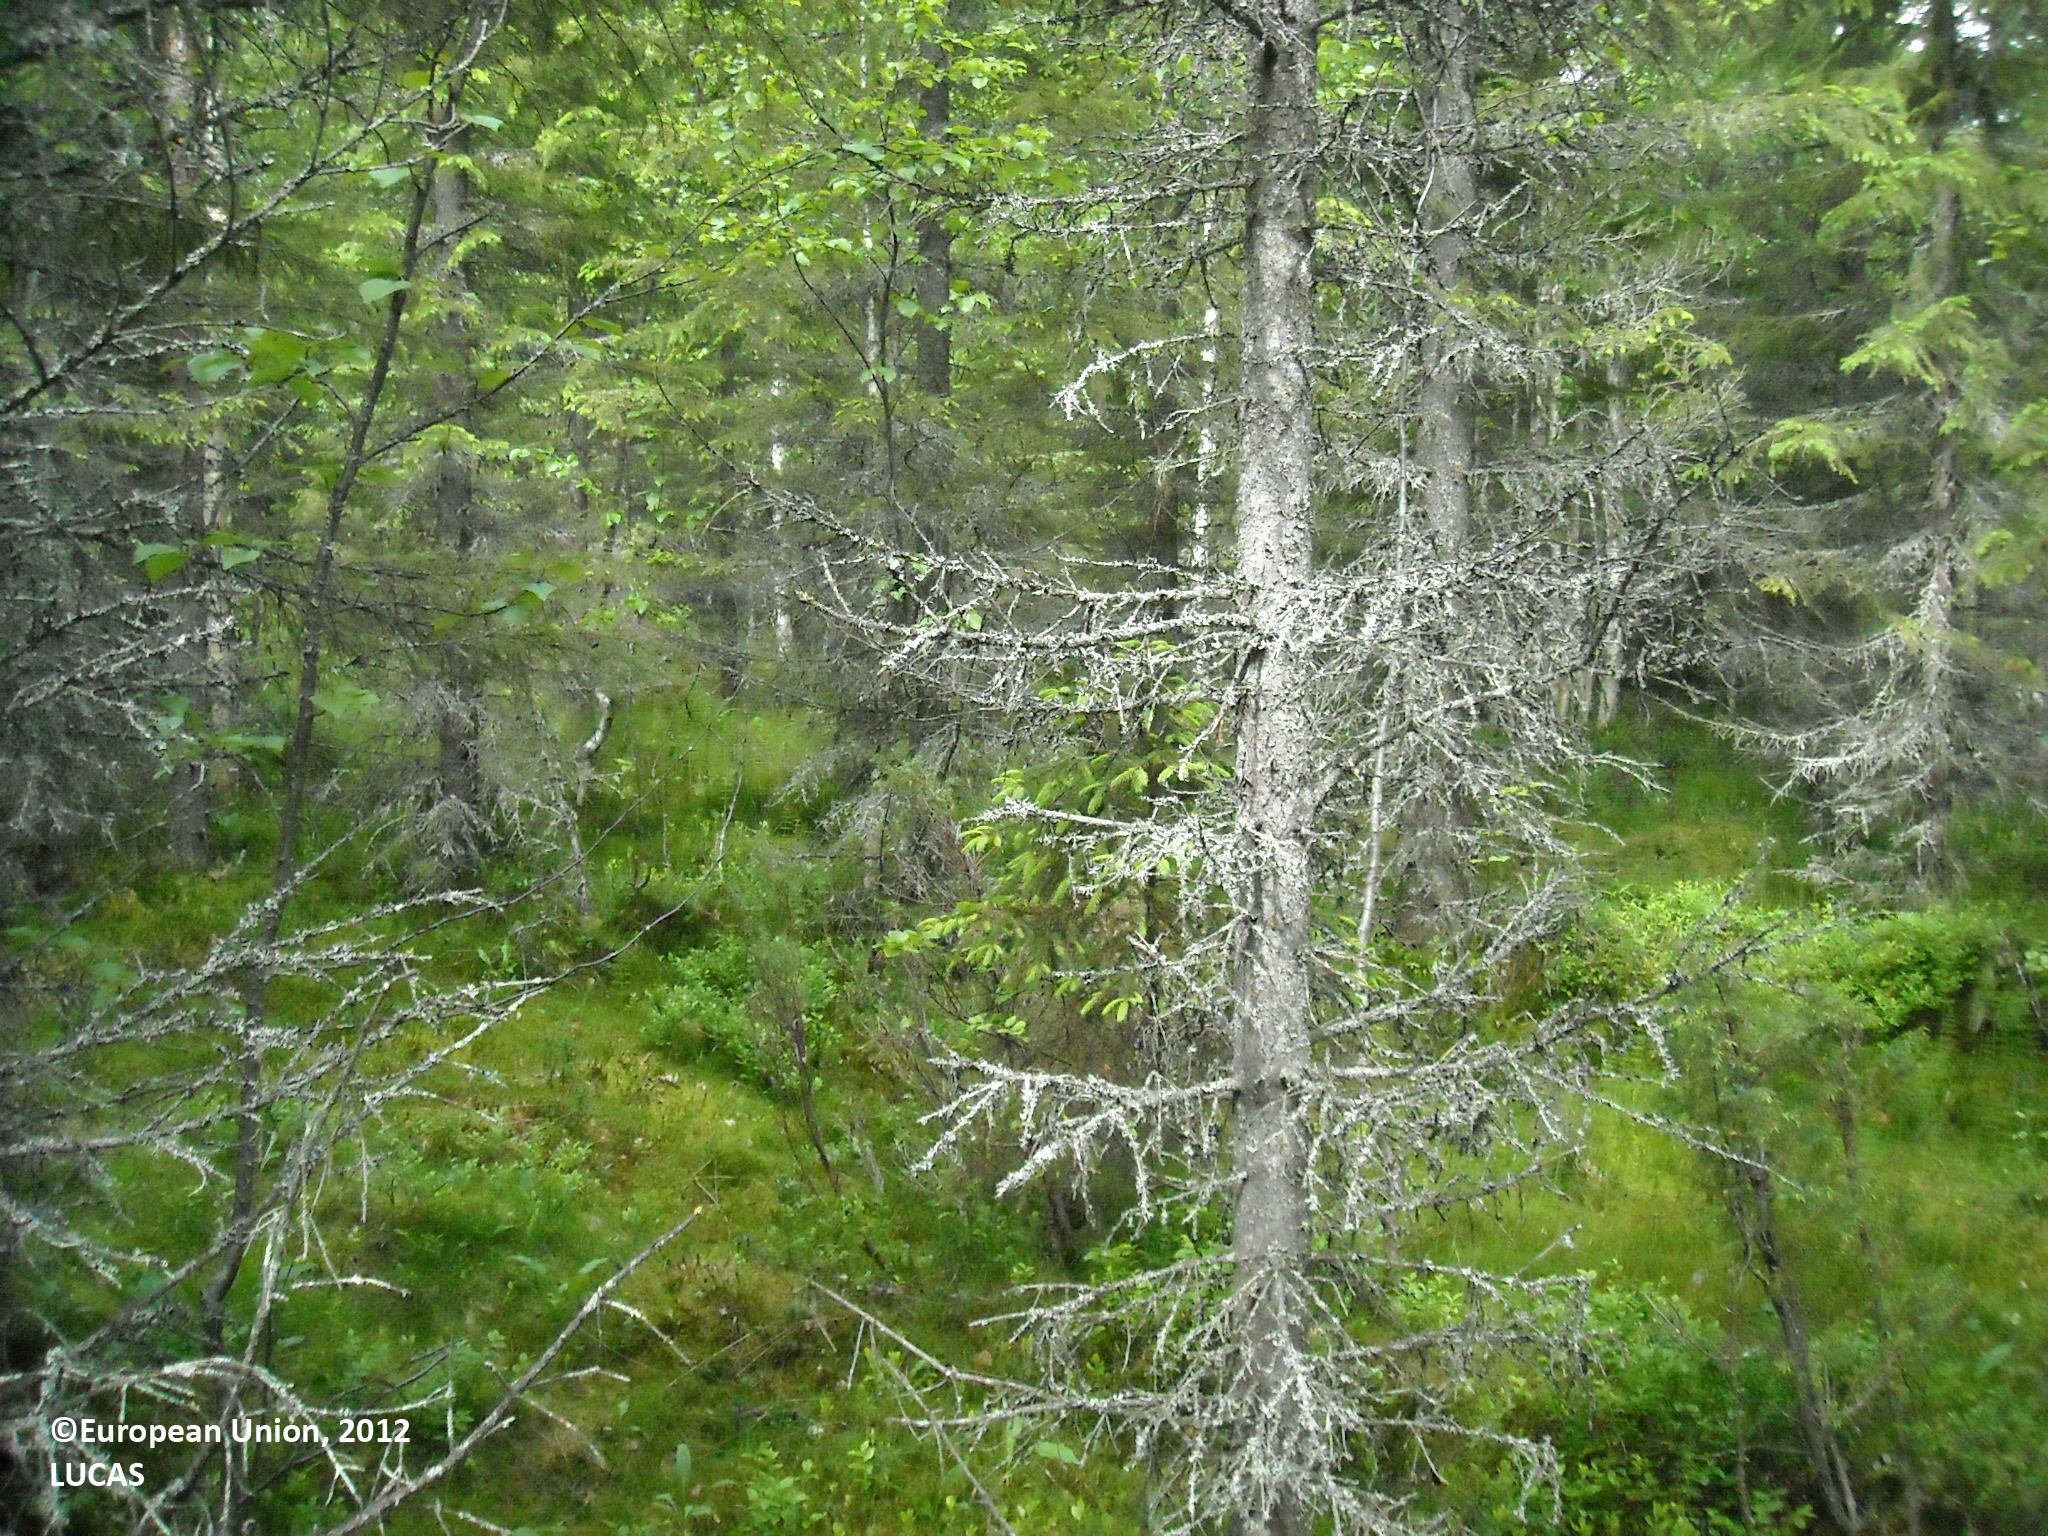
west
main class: Woodland
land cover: Spruce dominated coniferous woodland
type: boreal forest
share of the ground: > 75 %
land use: Forestry
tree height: > 5 m
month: June
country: FI
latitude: 64.8067
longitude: 27.8572
